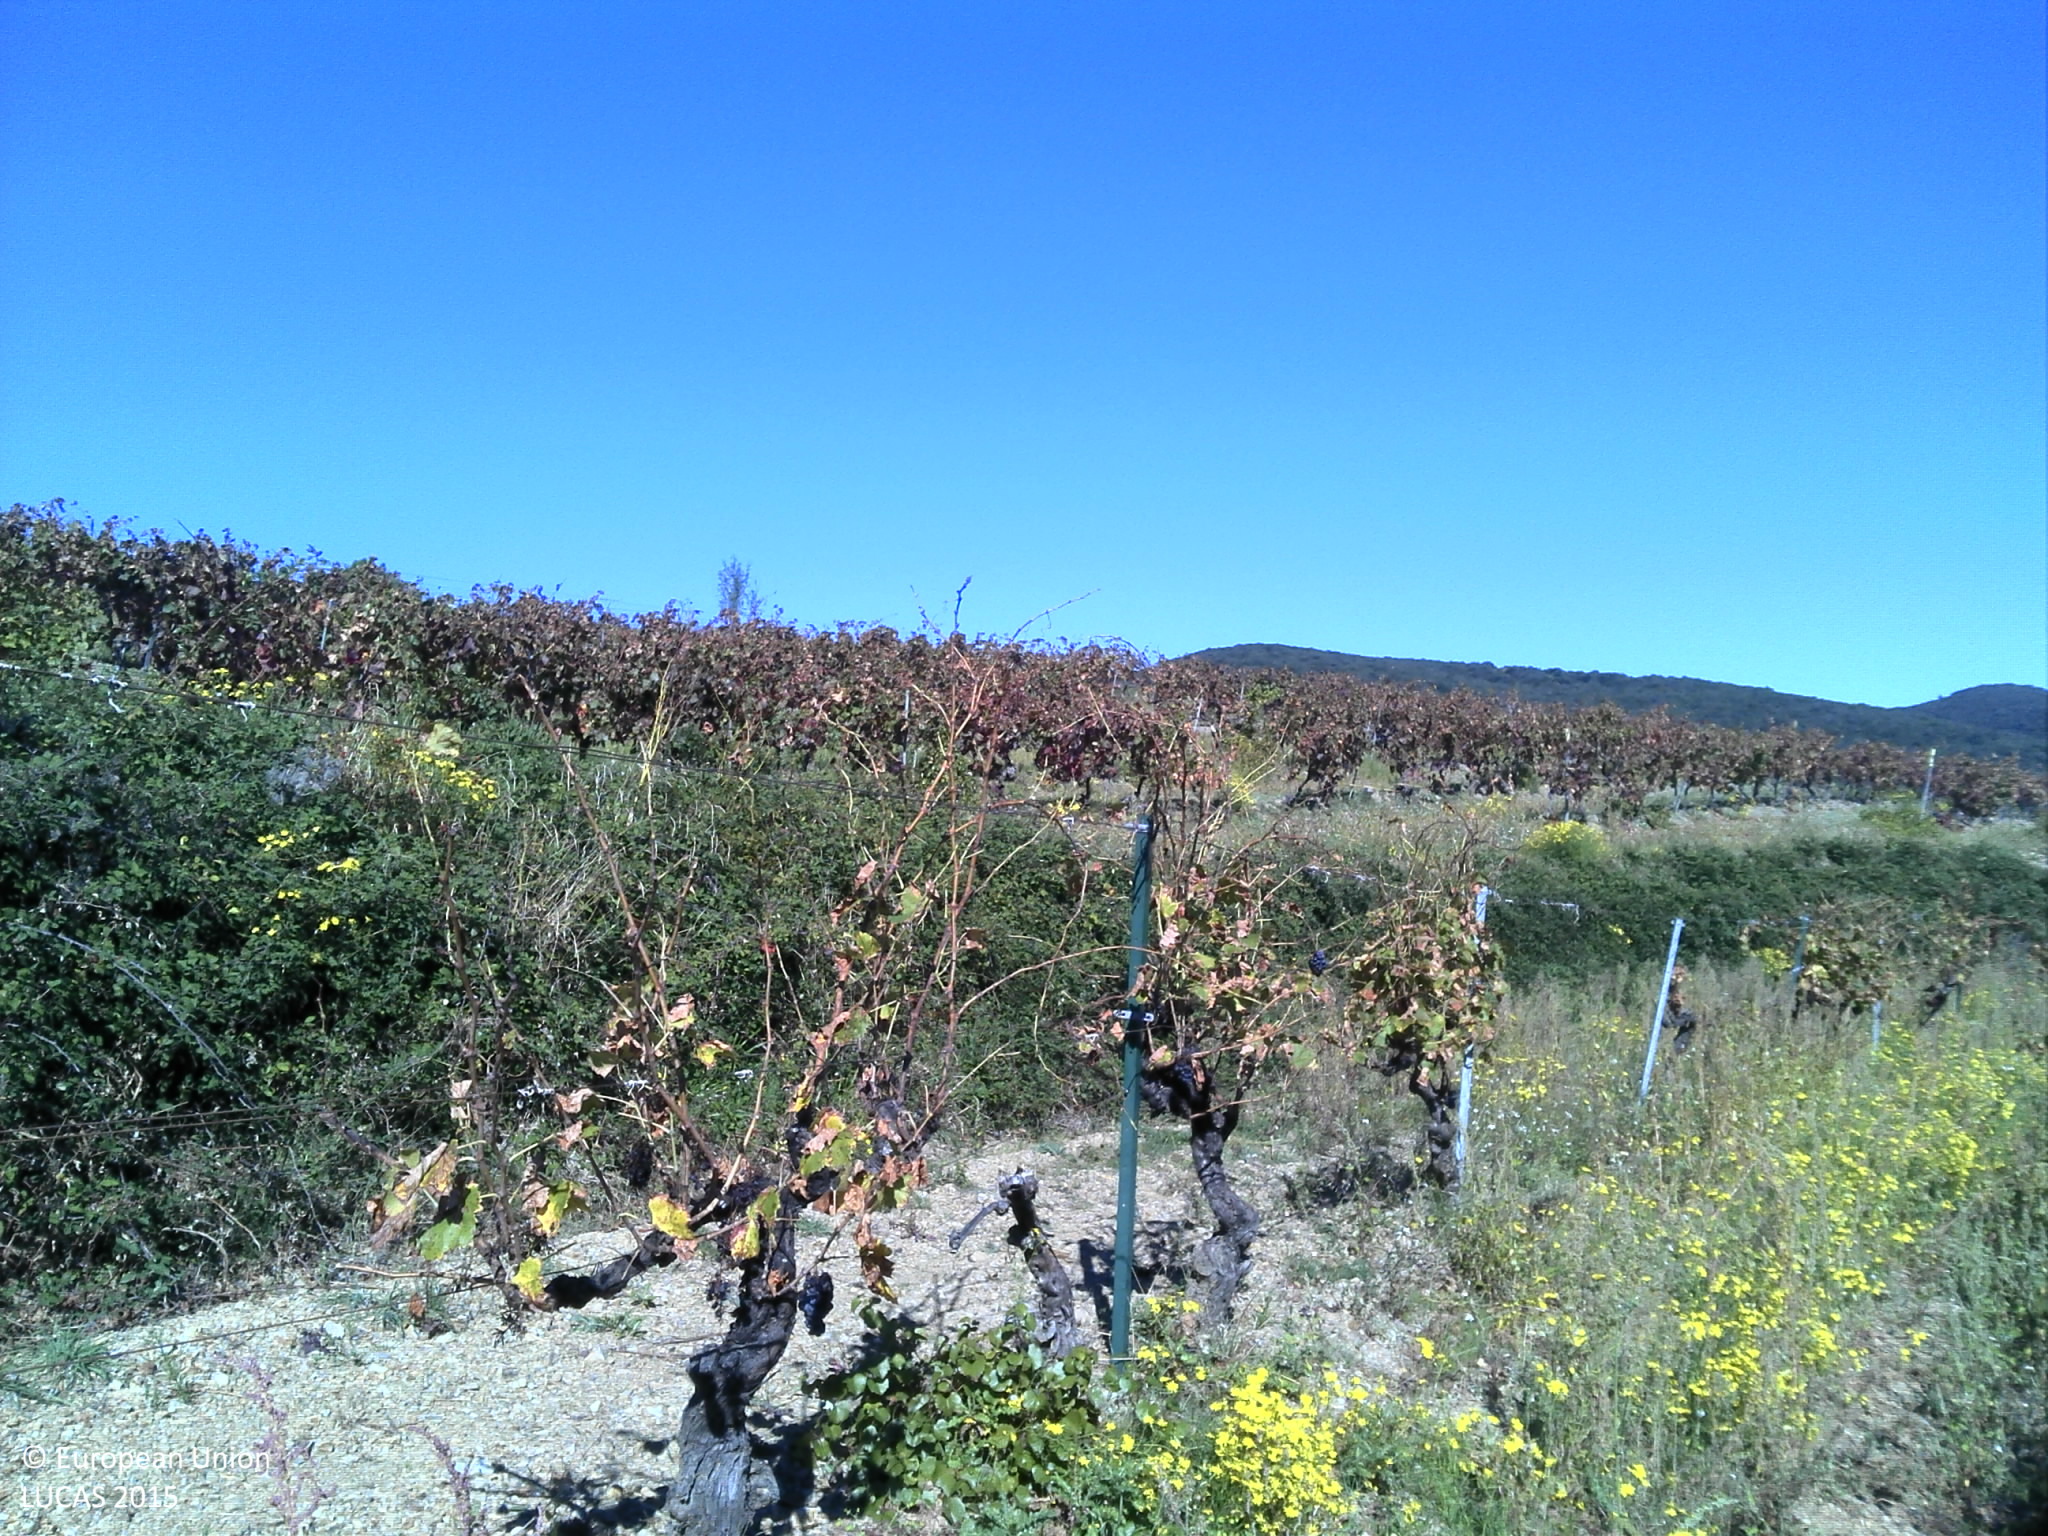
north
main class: Cropland
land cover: Vineyards
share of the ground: 10 - 25 %
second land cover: Spontaneously vegetated surfaces
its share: 50 - 75 %
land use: Agriculture (excluding fallow land and kitchen gardens)
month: October
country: FR
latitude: 43.5442
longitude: 3.1394
